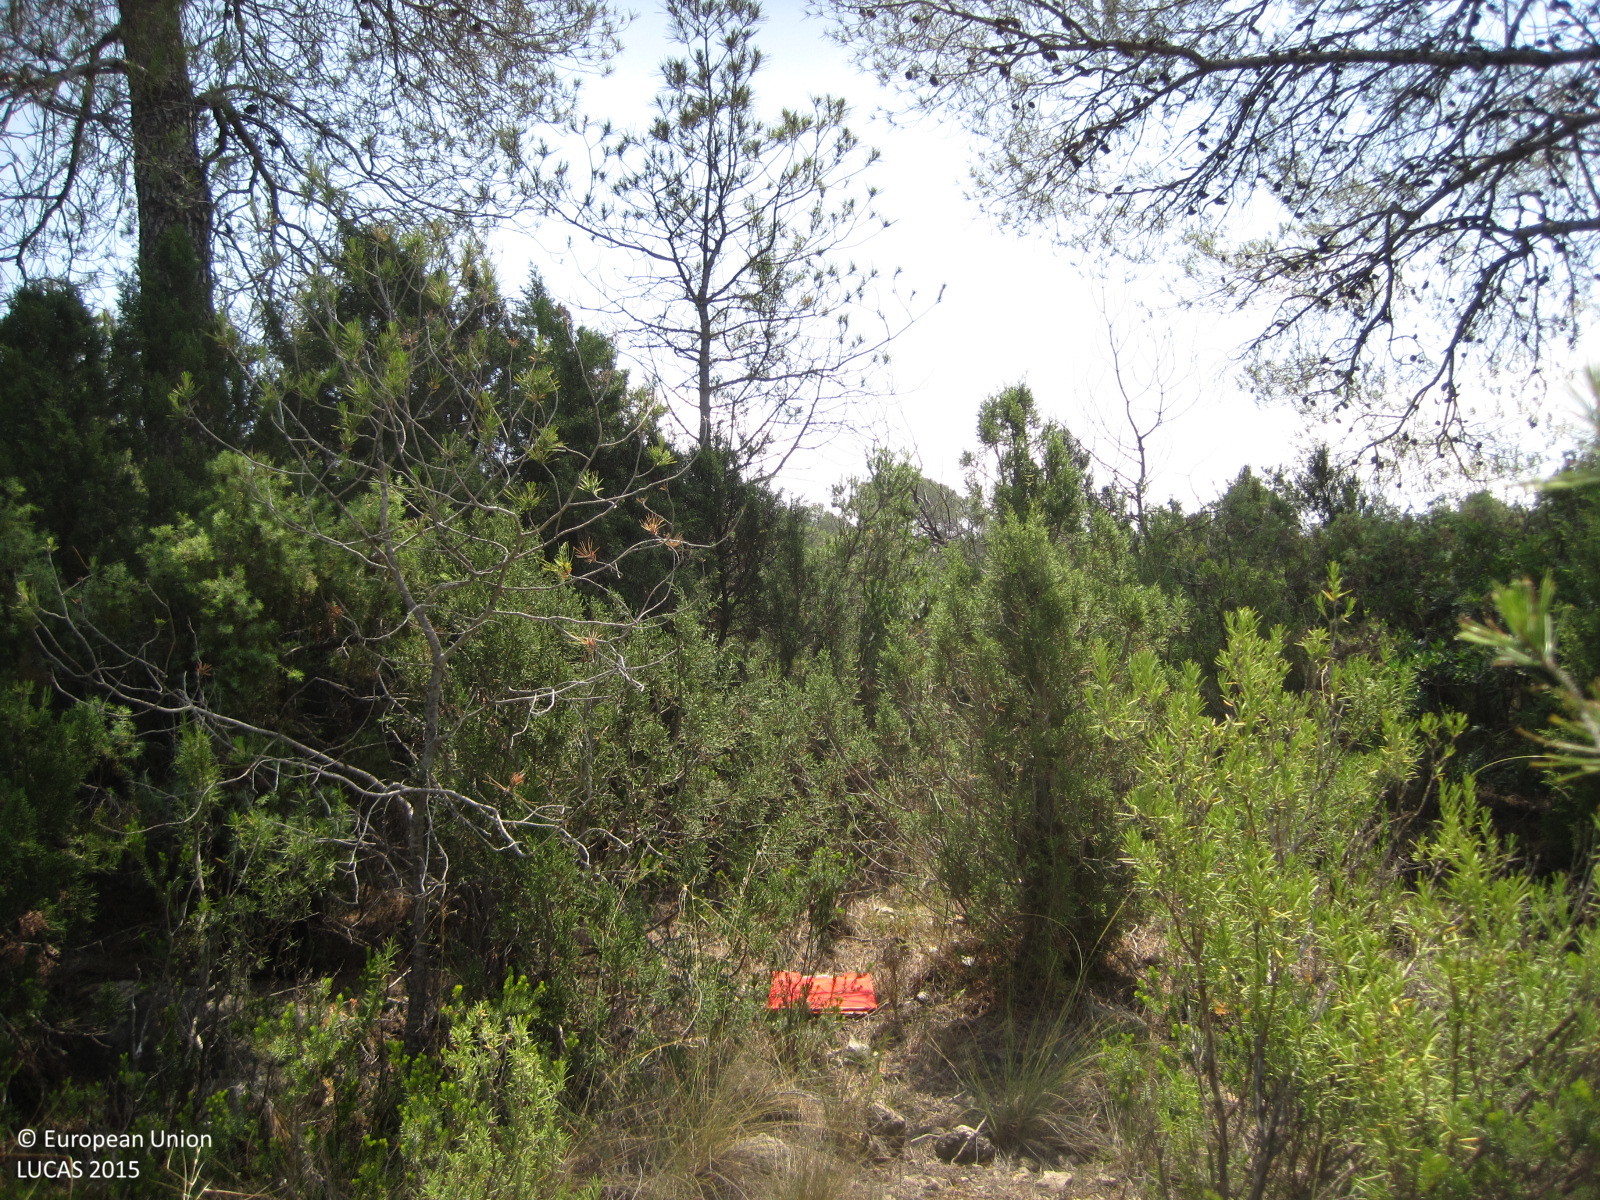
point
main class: Woodland
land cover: Pine dominated coniferous woodland
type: coniferous forest of the mediterranean region
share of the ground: 25 - 50 %
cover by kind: shrubs 45 %, coniferous forest trees 30 %, herbaceous plants 20 %, consolidated bare surface 5 %
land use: Forestry
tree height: > 5 m
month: June
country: ES
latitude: 39.7425
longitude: -0.9610
